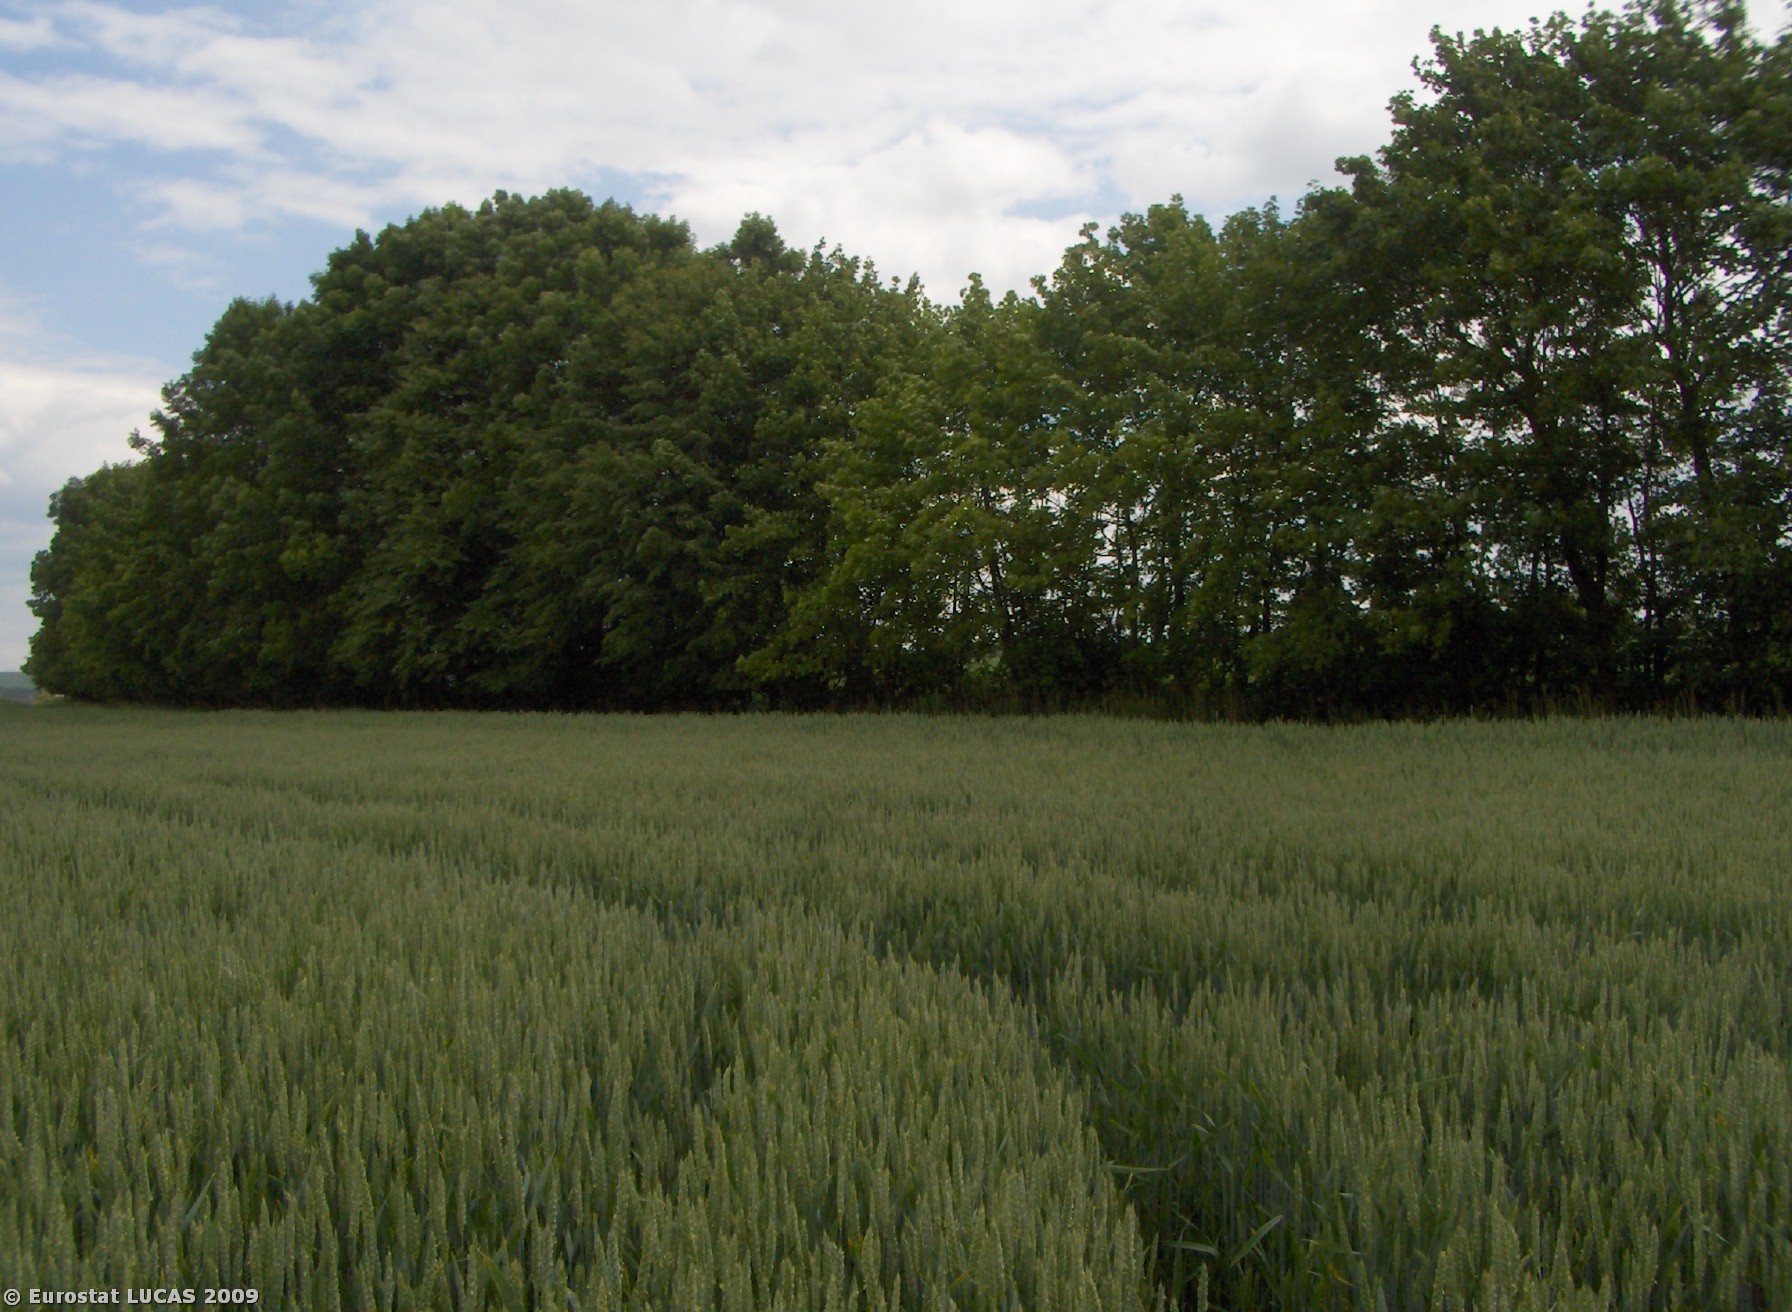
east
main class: Cropland
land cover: Common wheat
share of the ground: > 75 %
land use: Agriculture (excluding fallow land and kitchen gardens)
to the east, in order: Common wheat; Tracks; Broadleaved woodland; Rivers and streams; Broadleaved woodland; Rape and turnip rape
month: June
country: CZ
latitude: 49.4671
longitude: 17.5047
